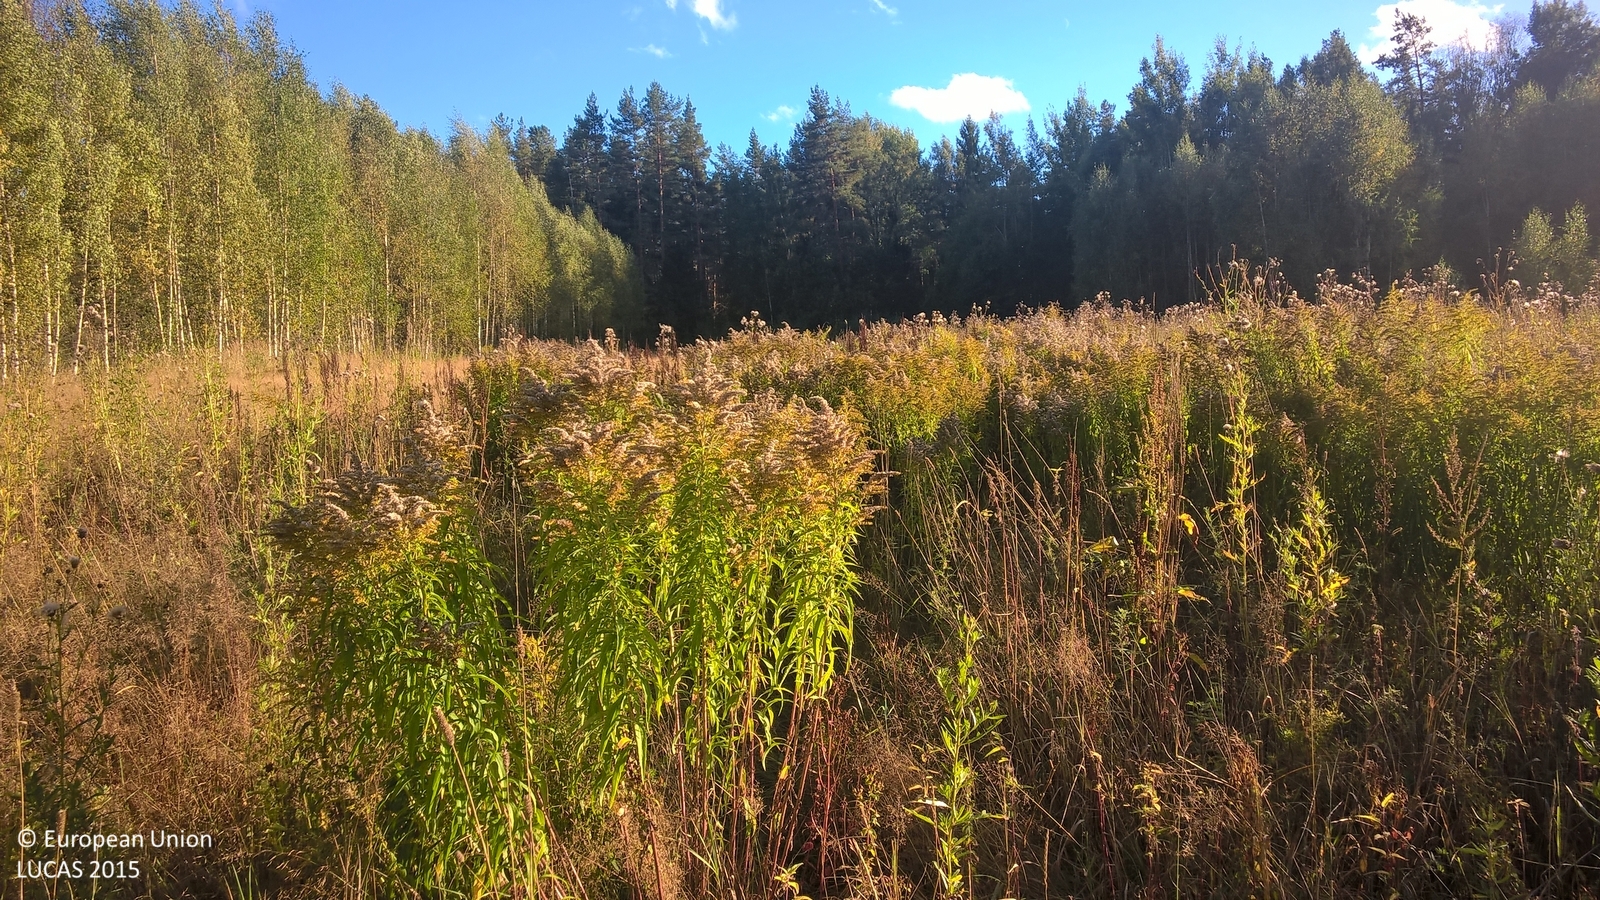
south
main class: Grassland
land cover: Spontaneously vegetated surfaces
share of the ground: > 75 %
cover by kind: herbaceous plants 100 %
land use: Fallow land
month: September
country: LV
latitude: 57.6046
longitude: 25.6657
